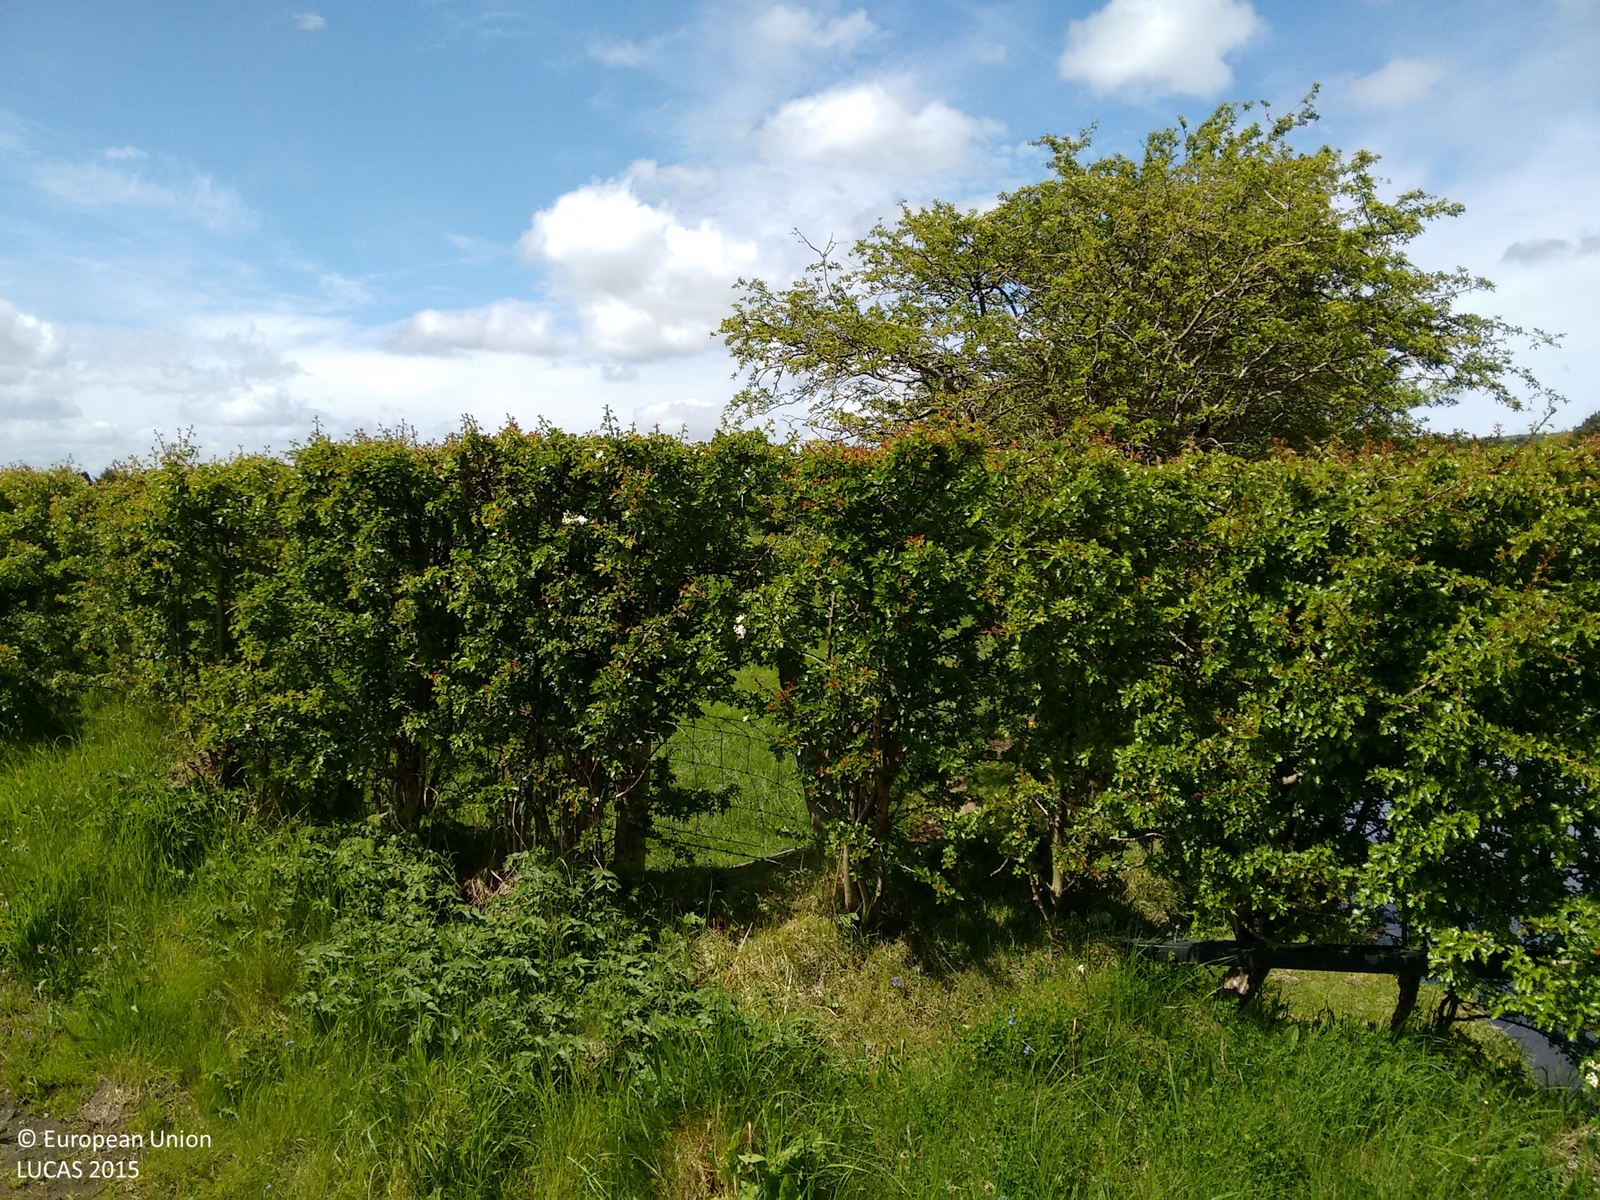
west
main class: Grassland
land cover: Grassland without tree/shrub cover
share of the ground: > 75 %
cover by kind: herbaceous plants 100 %
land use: Agriculture (excluding fallow land and kitchen gardens)
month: June
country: IE
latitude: 53.2189
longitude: -6.4654
